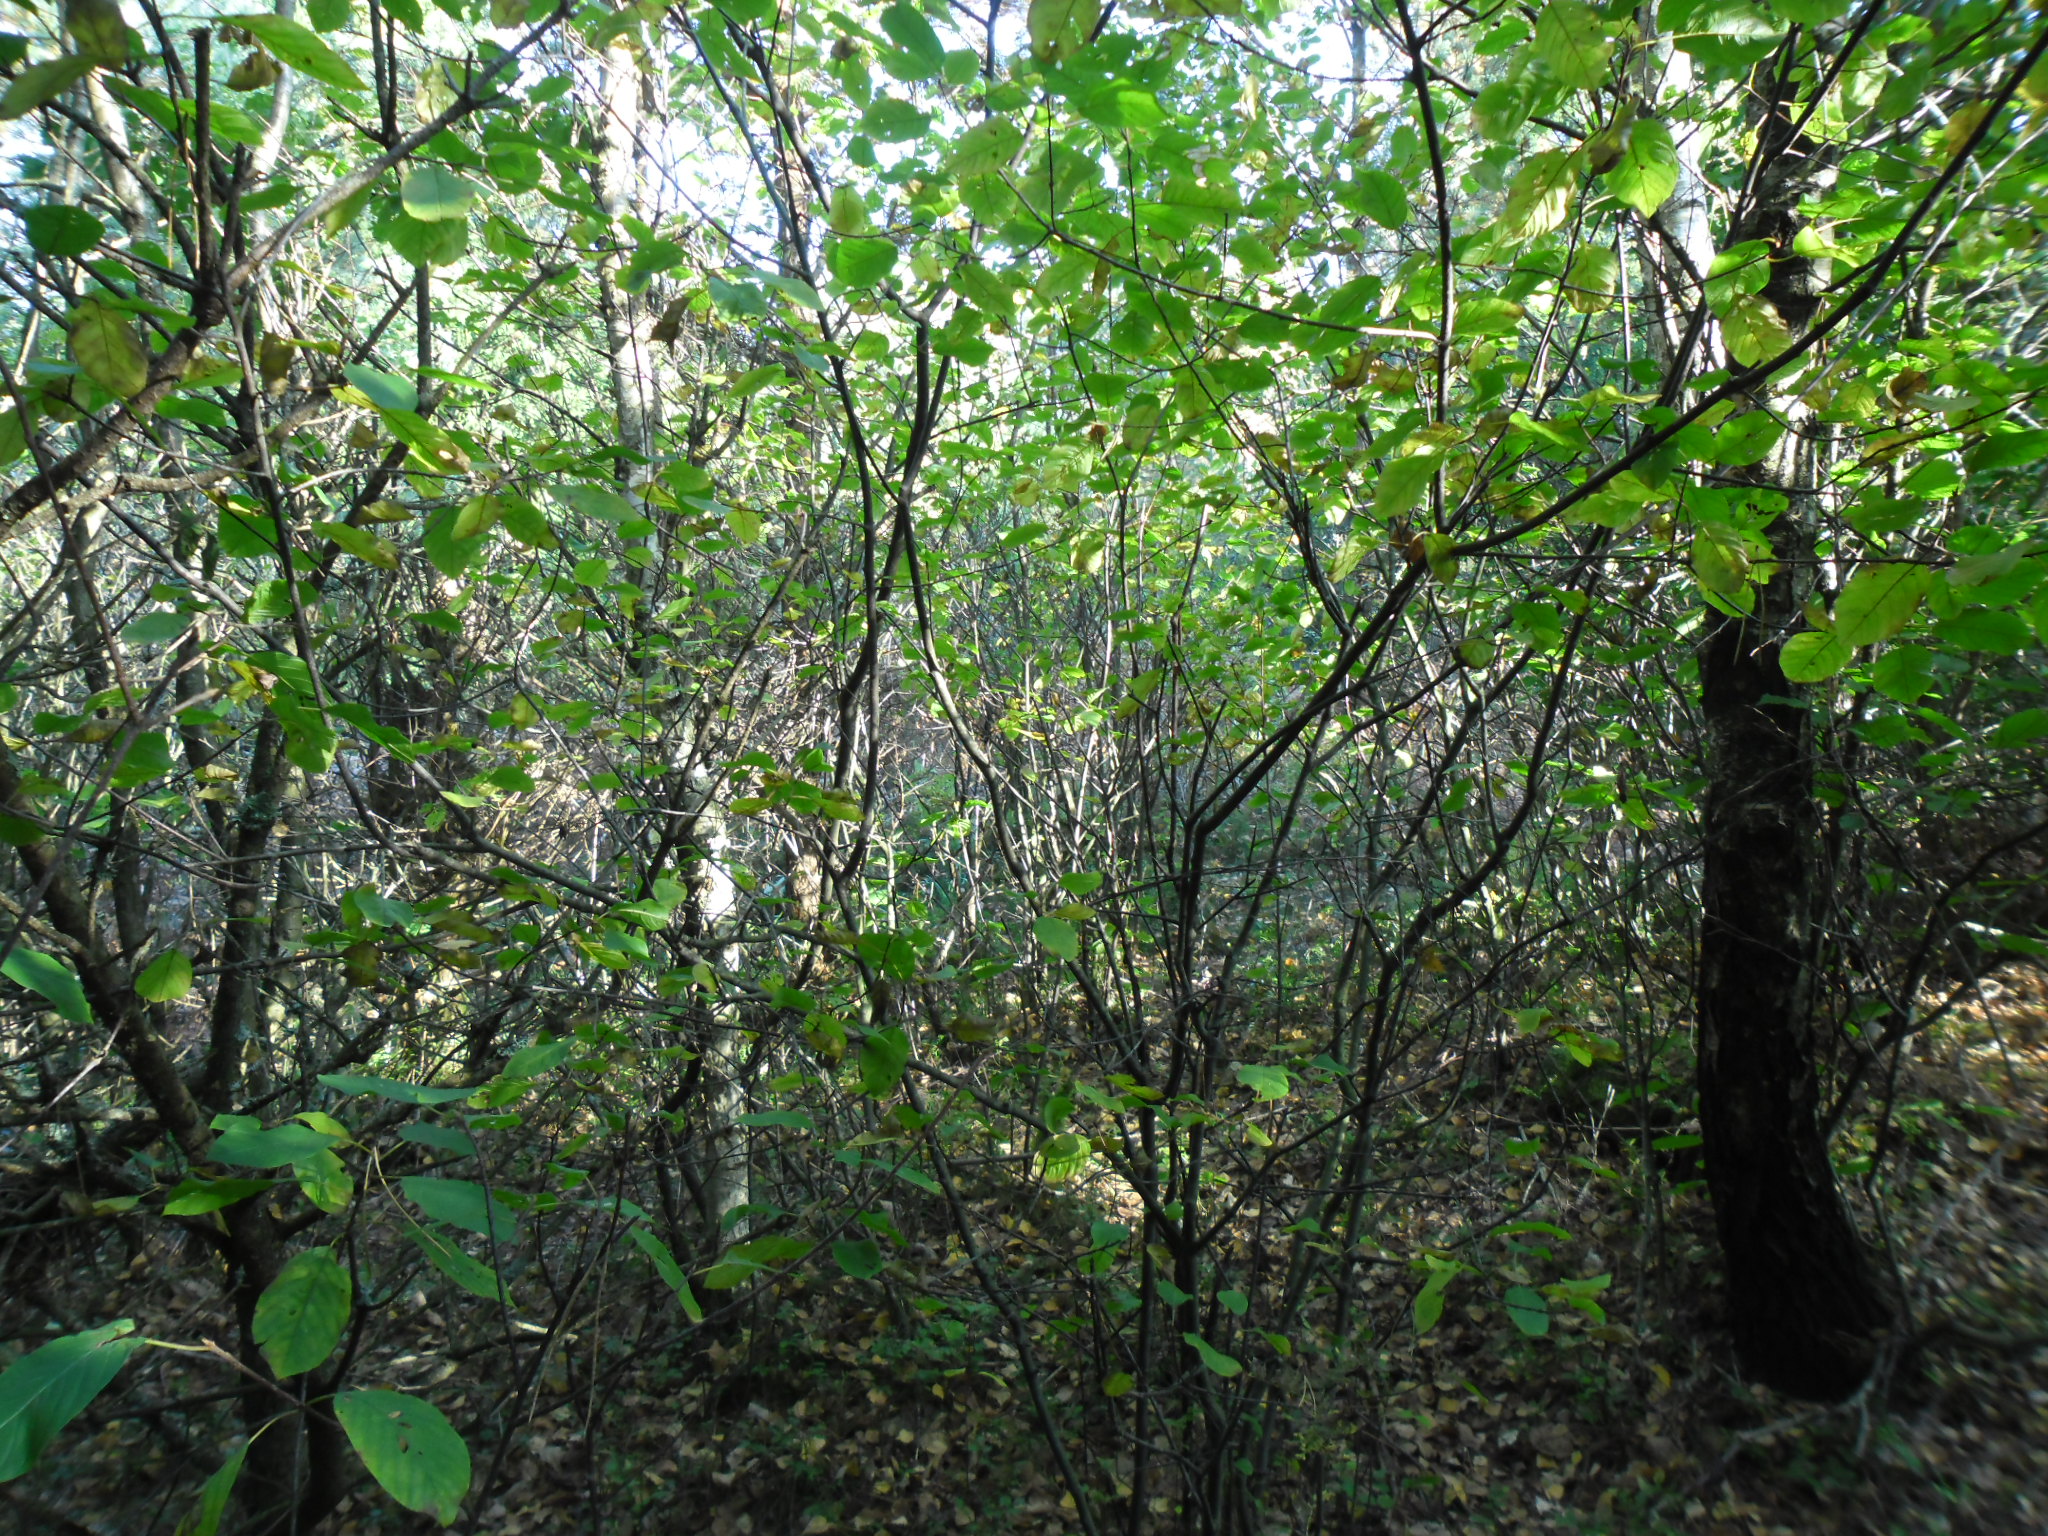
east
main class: Woodland
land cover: Other mixed woodland
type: acidophilous oak and oak-birch forest
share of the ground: > 75 %
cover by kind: broadleaved forest trees 50 %, coniferous forest trees 30 %, shrubs 10 %, unconsolidated bare surface 10 %
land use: Semi-natural and natural areas not in use
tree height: > 5 m
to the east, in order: Other mixed woodland; Broadleaved woodland
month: October
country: SE
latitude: 56.5984
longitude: 13.1730
